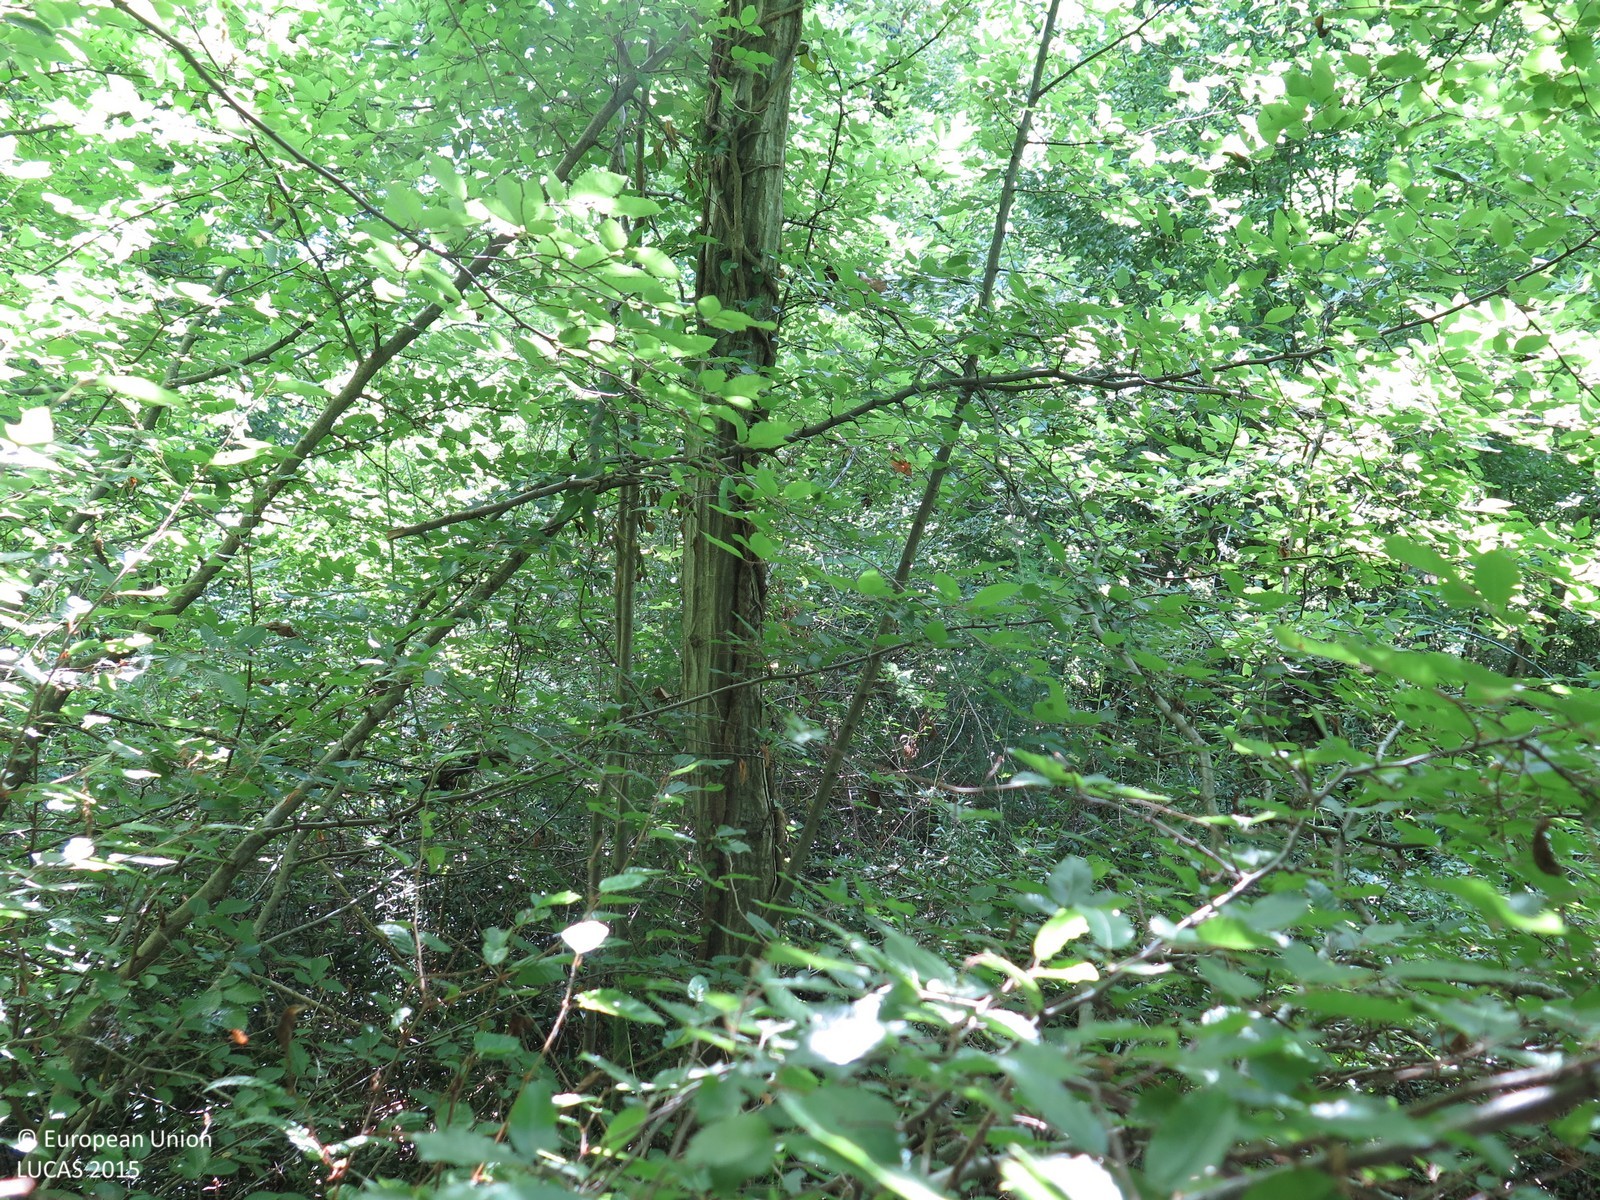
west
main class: Woodland
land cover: Broadleaved woodland
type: beech forest
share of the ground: > 75 %
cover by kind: broadleaved forest trees 90 %, shrubs 5 %, herbaceous plants 5 %
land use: Semi-natural and natural areas not in use
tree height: > 5 m
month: June
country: HR
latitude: 45.2608
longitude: 13.6524
